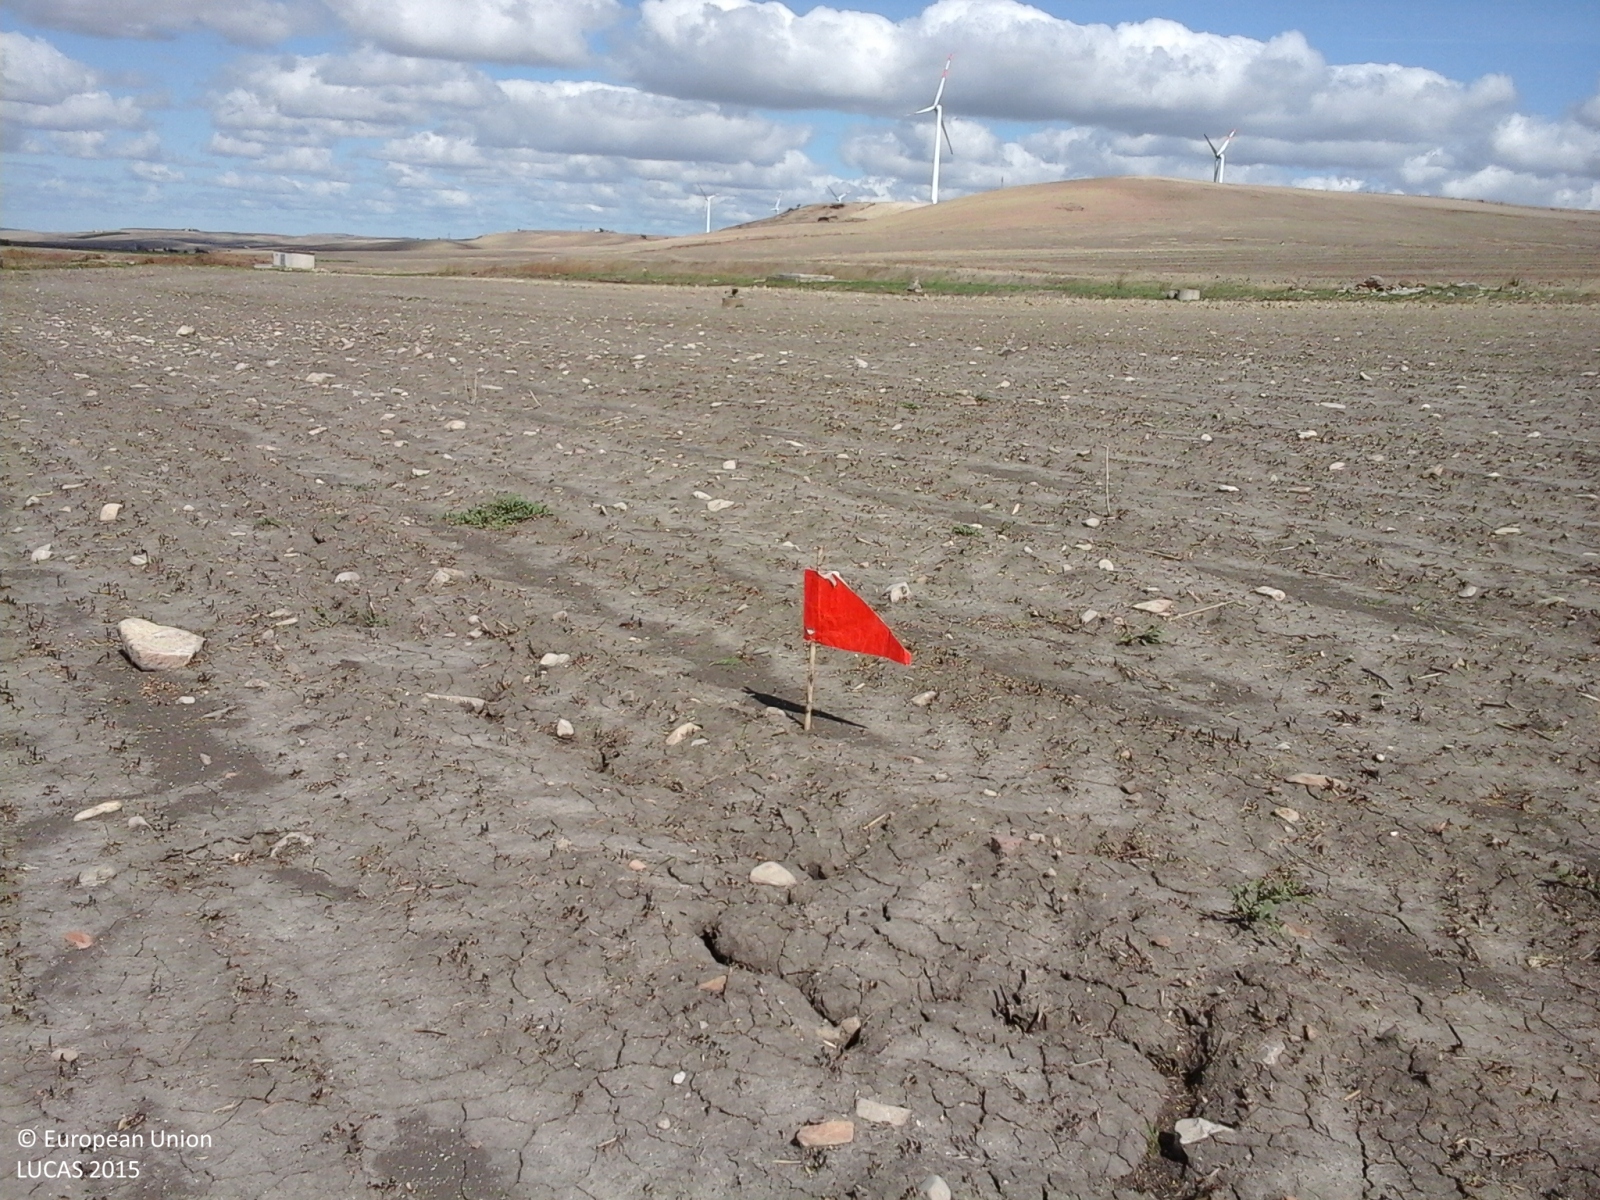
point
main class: Cropland
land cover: Durum wheat
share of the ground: > 75 %
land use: Agriculture (excluding fallow land and kitchen gardens)
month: September
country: IT
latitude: 41.6332
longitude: 15.2049
